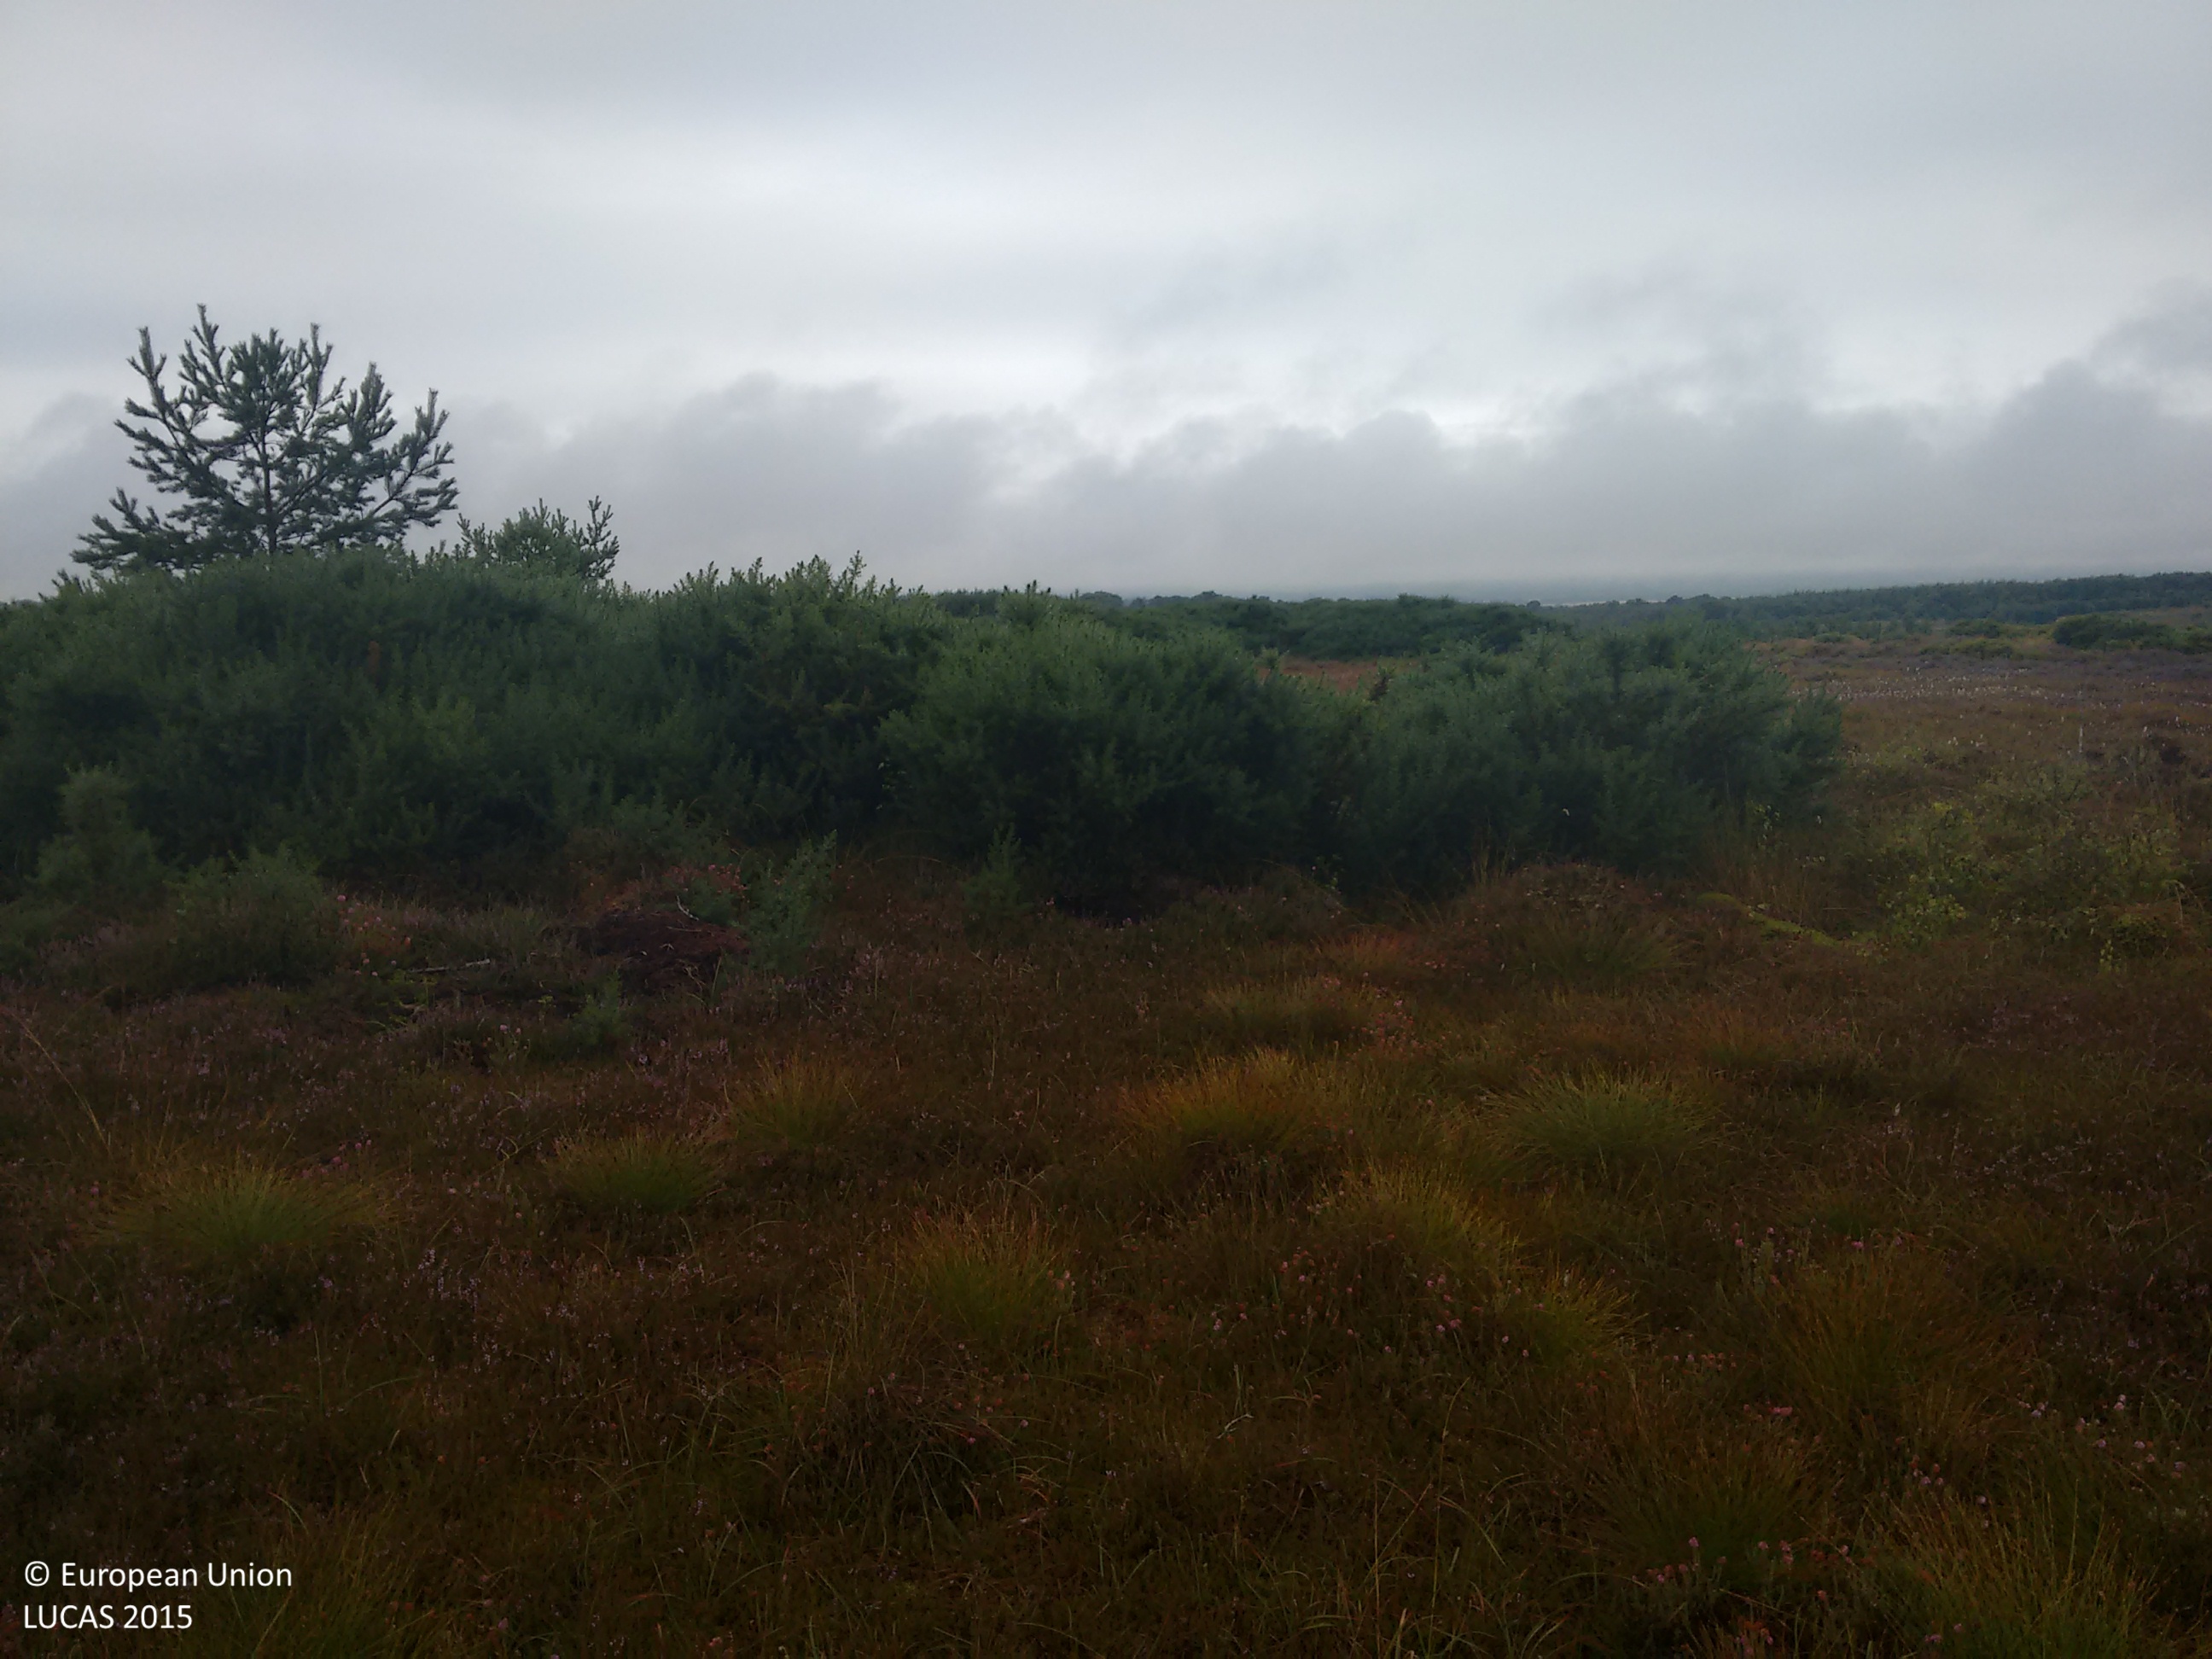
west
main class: Shrubland
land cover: Shrubland without tree cover
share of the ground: > 75 %
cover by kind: shrubs 55 %, herbaceous plants 40 %, lichens and mosses 5 %
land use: Semi-natural and natural areas not in use
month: August
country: GB
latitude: 57.7937
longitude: -3.9908
